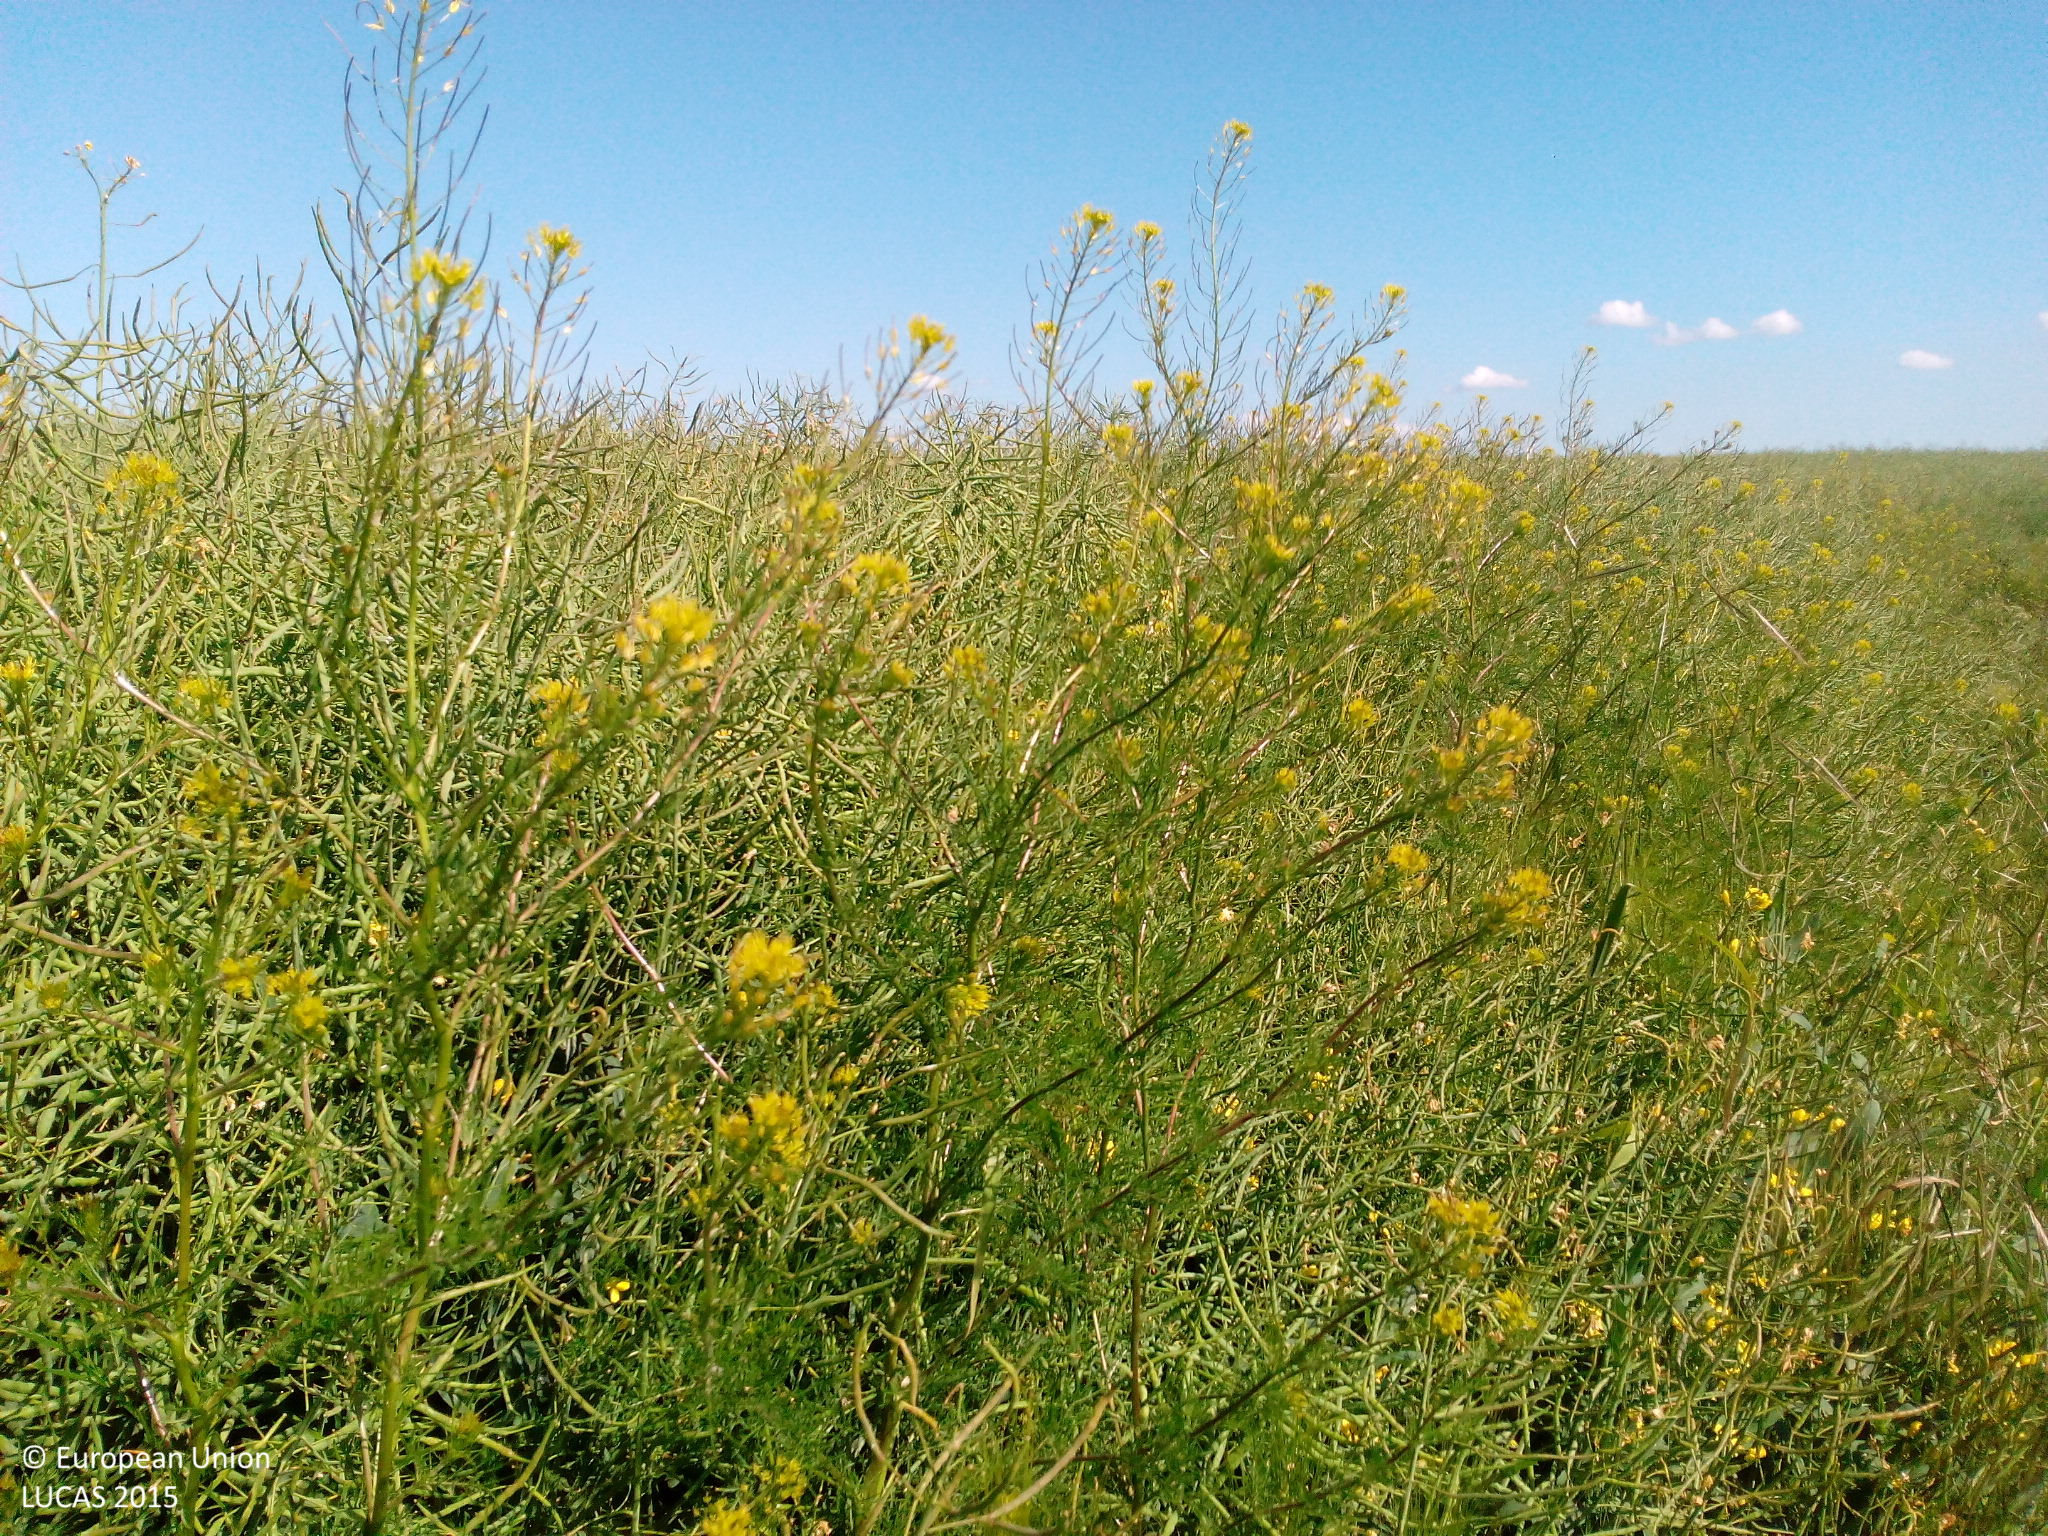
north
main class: Cropland
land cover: Rape and turnip rape
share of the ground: > 75 %
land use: Agriculture (excluding fallow land and kitchen gardens)
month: June
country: DE
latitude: 53.3189
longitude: 12.6564
